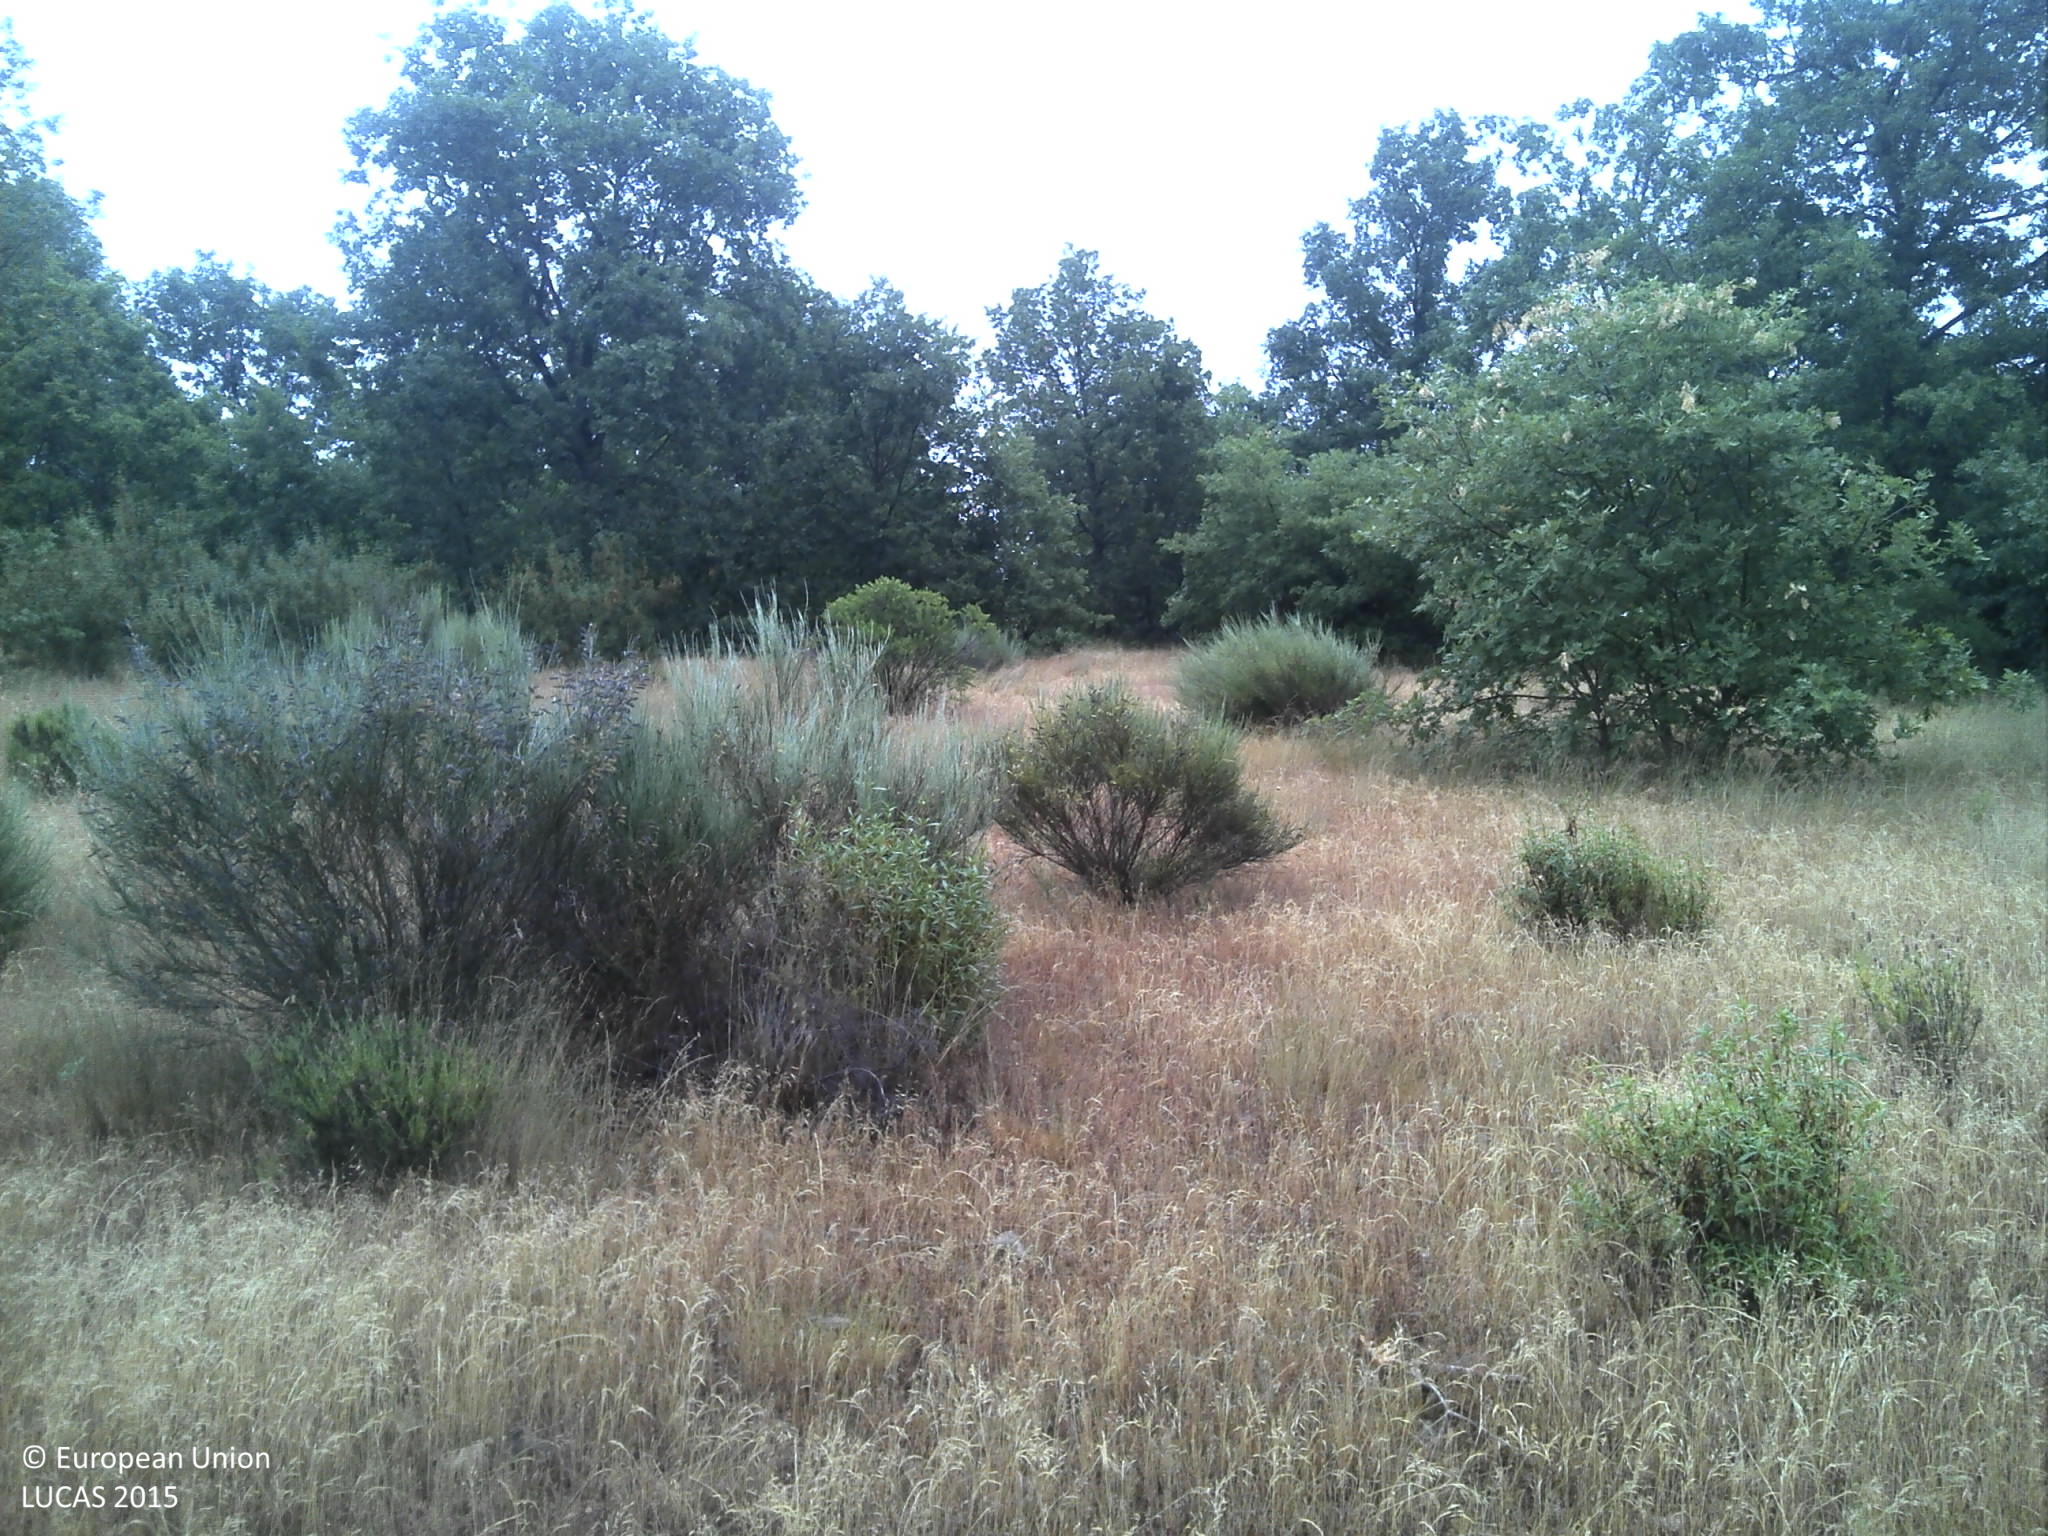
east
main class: Woodland
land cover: Broadleaved woodland
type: acidophilous oak and oak-birch forest
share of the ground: 25 - 50 %
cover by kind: broadleaved forest trees 35 %, herbaceous plants 30 %, unconsolidated bare surface 20 %, shrubs 15 %
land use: Forestry
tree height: > 5 m
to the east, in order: Broadleaved woodland; Grassland without tree/shrub cover; Broadleaved woodland; Fences; Broadleaved woodland
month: June
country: PT
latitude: 40.1979
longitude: -7.4795
